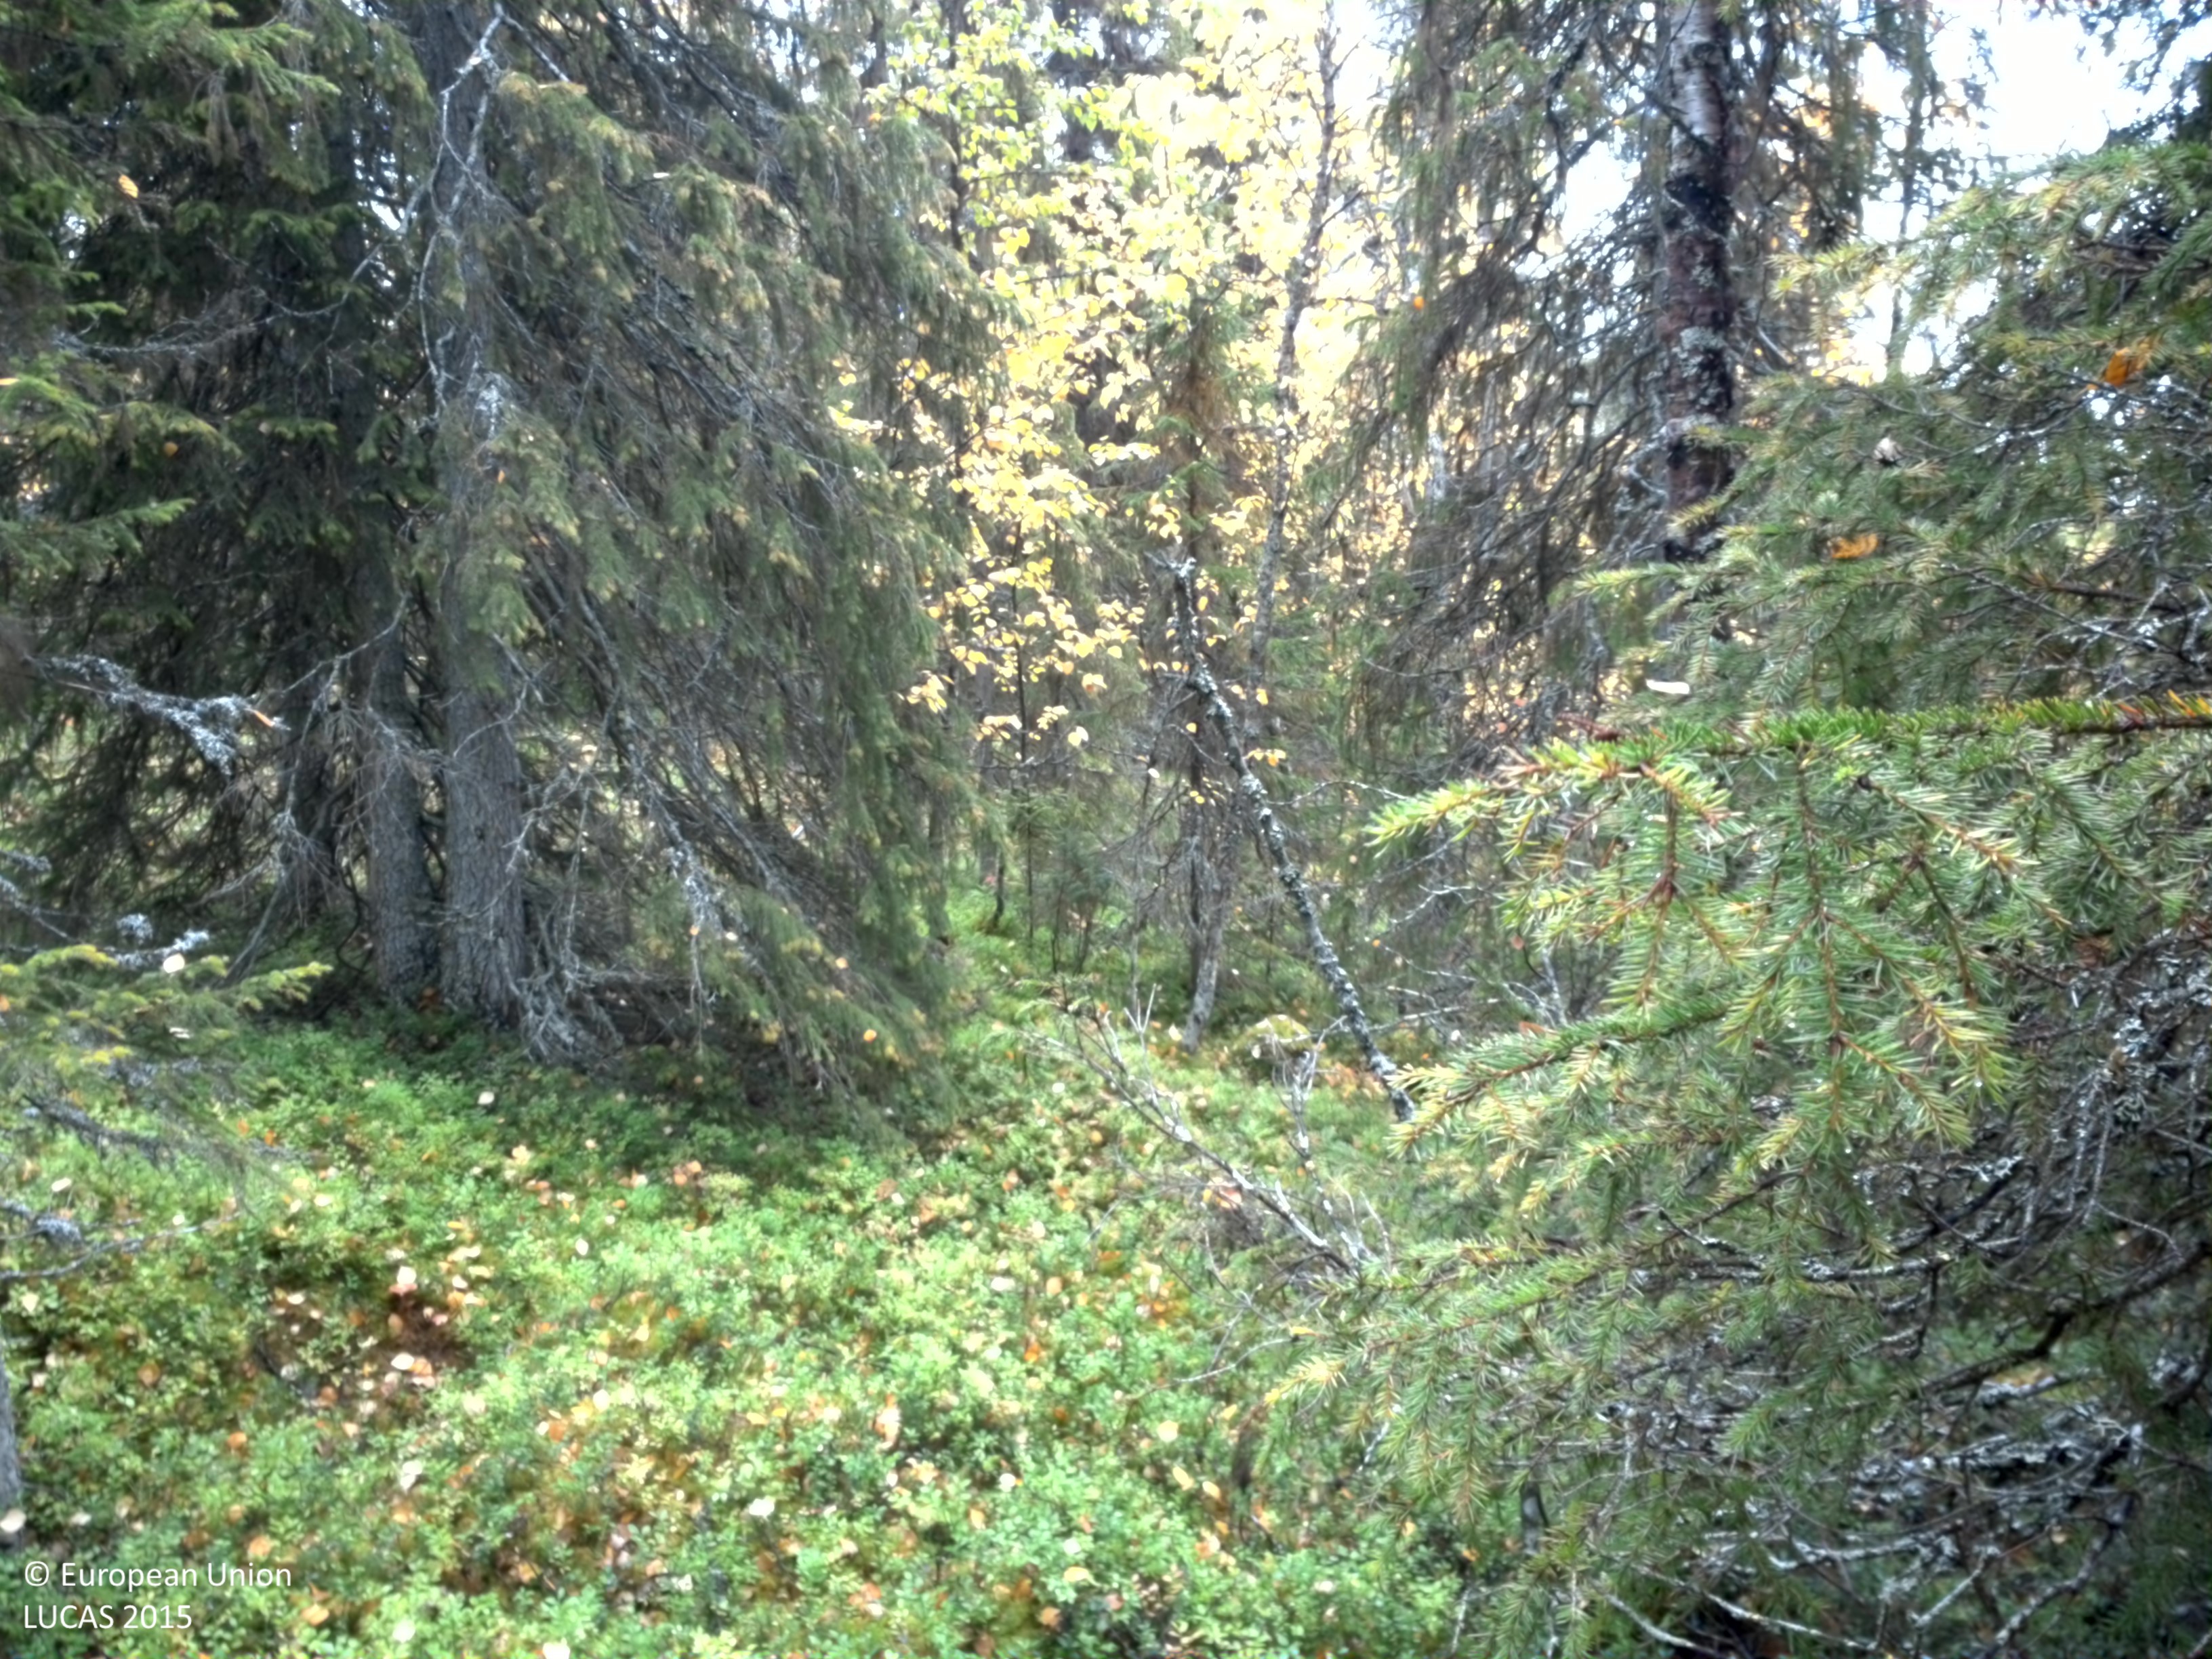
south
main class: Woodland
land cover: Spruce dominated coniferous woodland
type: boreal forest
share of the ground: 25 - 50 %
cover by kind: coniferous forest trees 35 %, shrubs 30 %, lichens and mosses 25 %, broadleaved forest trees 10 %
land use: Forestry
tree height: > 5 m
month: September
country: SE
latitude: 65.1102
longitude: 16.6714
